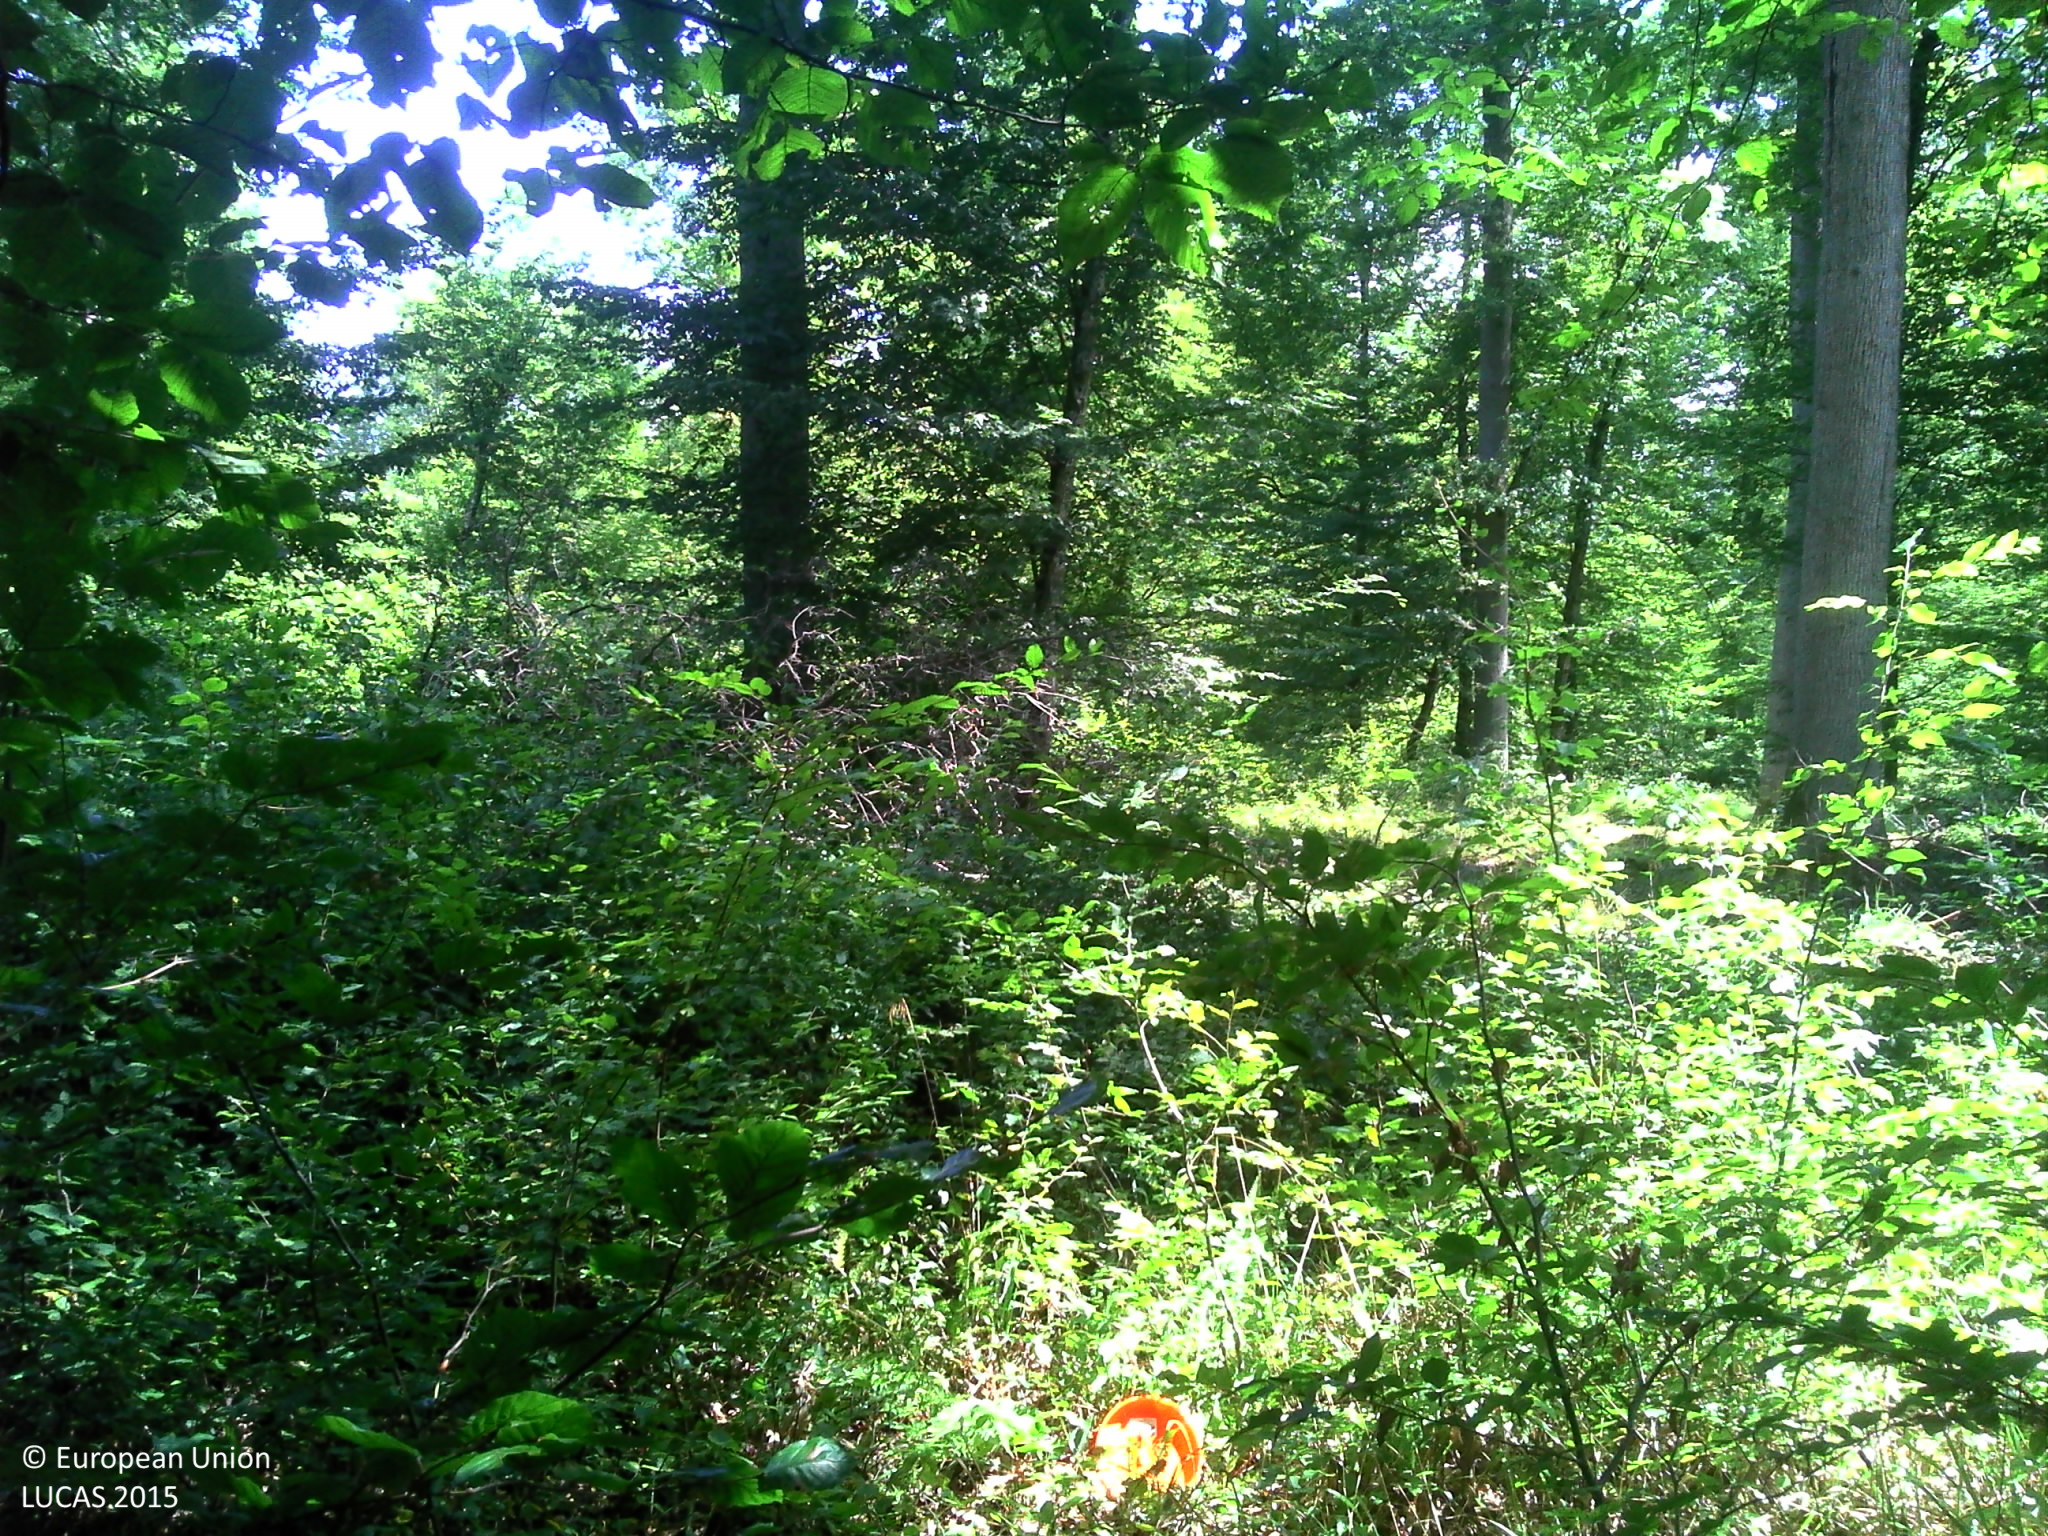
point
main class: Woodland
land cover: Broadleaved woodland
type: mesophytic deciduous forest
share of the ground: > 75 %
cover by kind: broadleaved forest trees 85 %, herbaceous plants 15 %
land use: Forestry
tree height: > 5 m
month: July
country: FR
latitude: 48.8661
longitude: 7.7241
